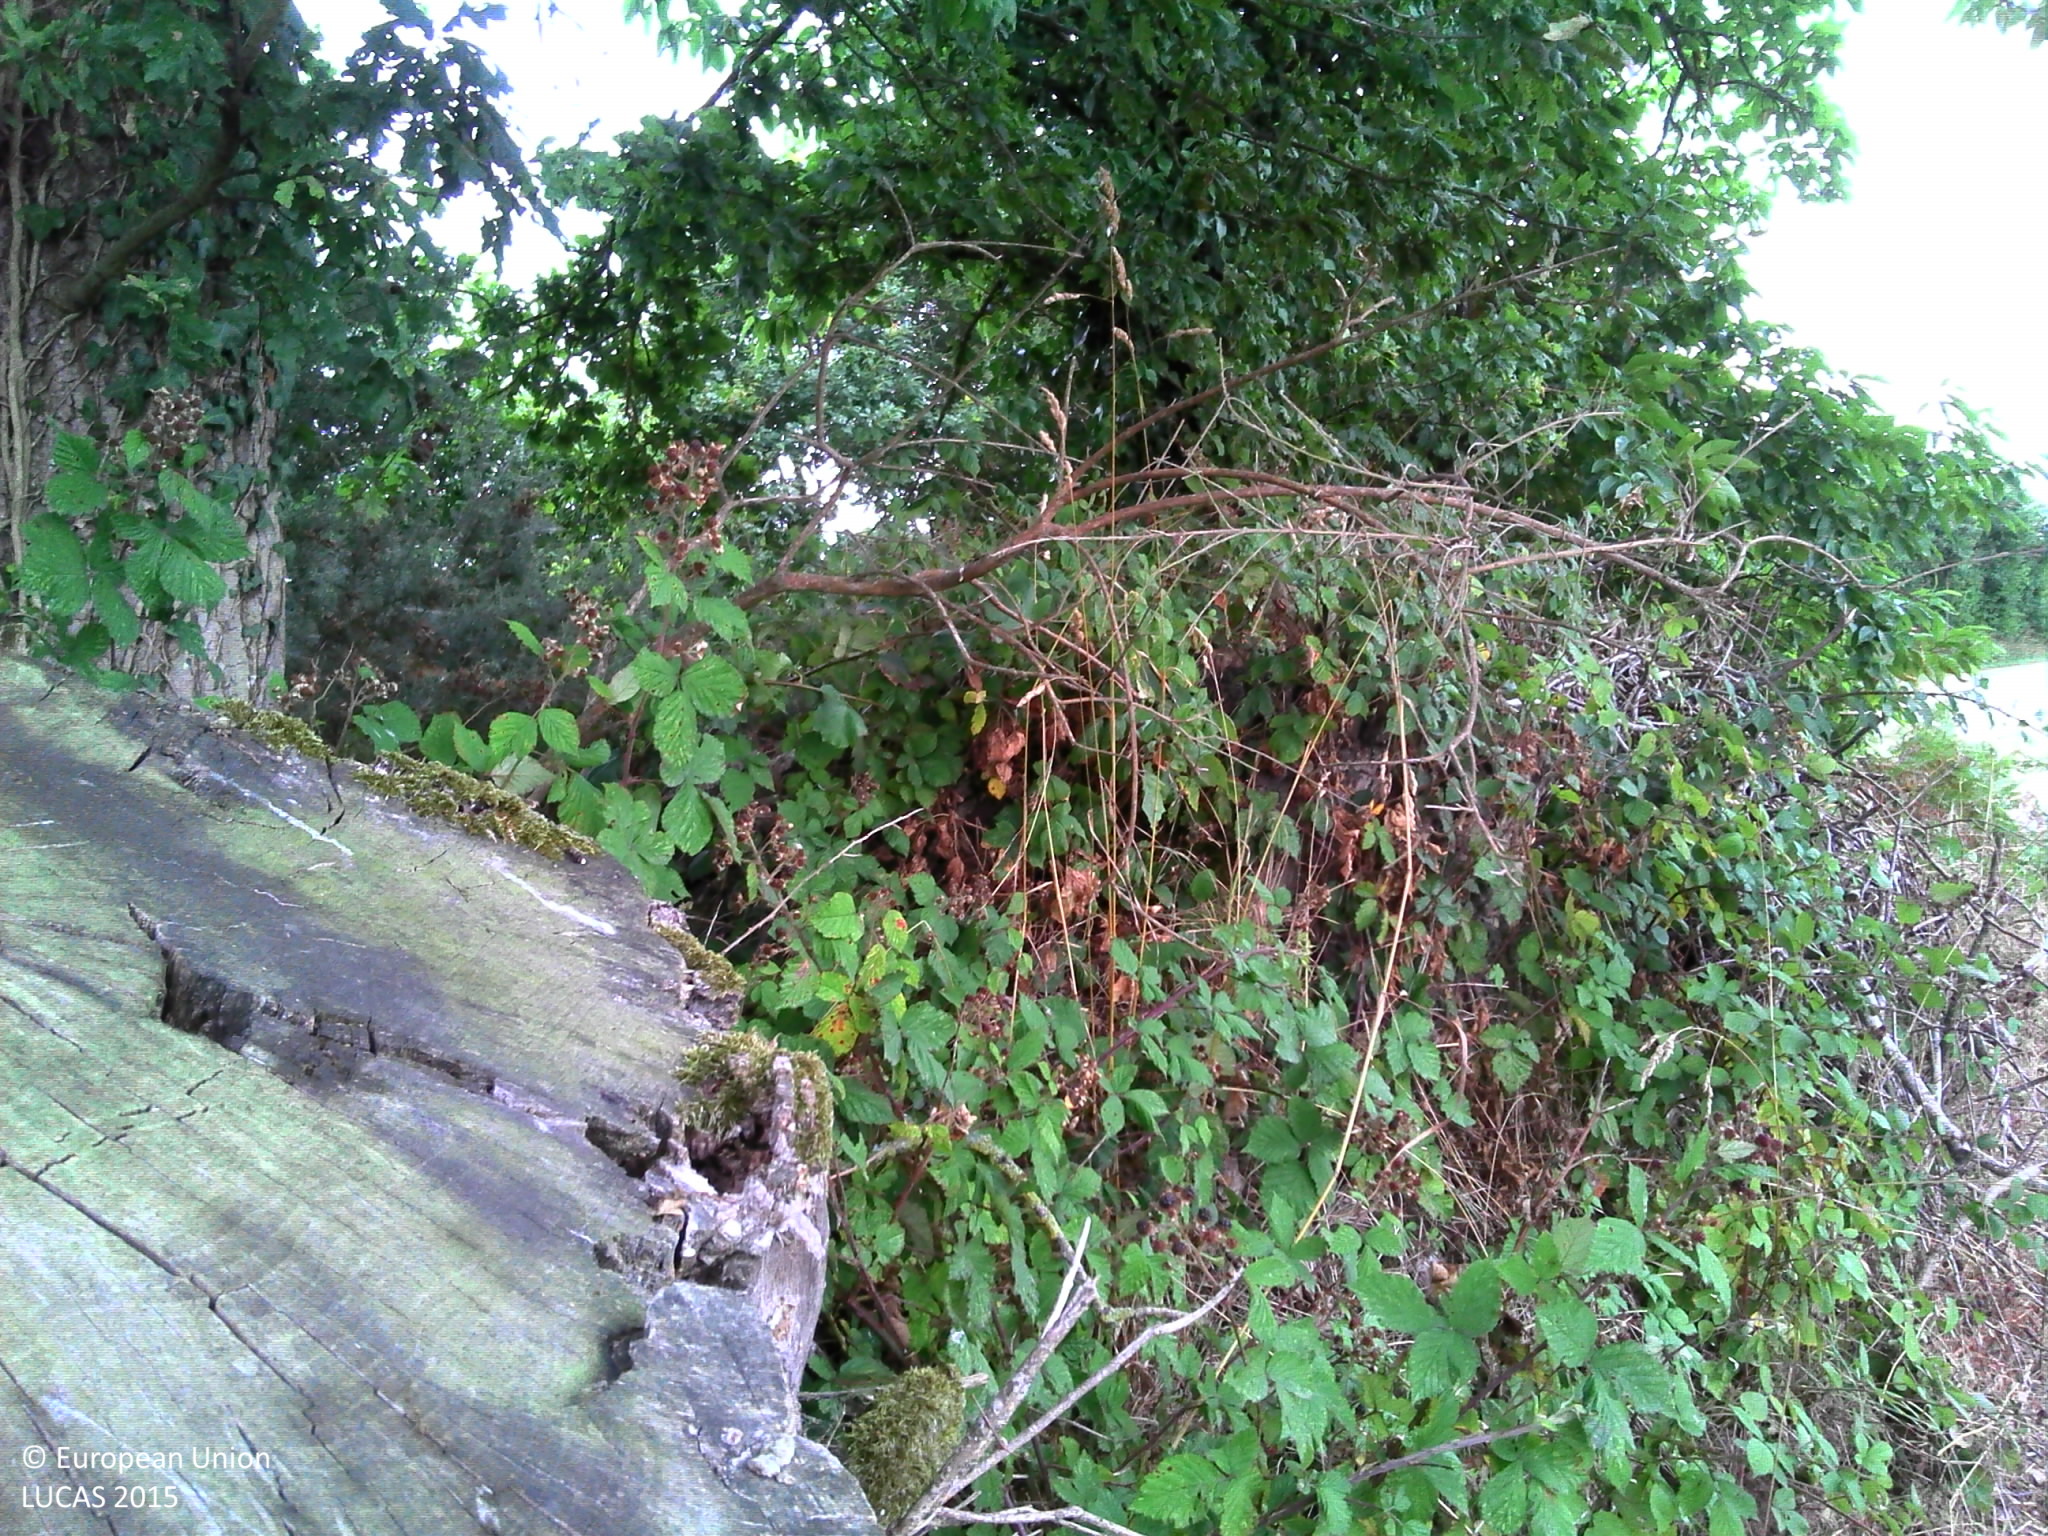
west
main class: Cropland
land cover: Common wheat
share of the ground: > 75 %
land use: Agriculture (excluding fallow land and kitchen gardens)
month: August
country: FR
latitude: 47.8110
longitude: -1.4074
